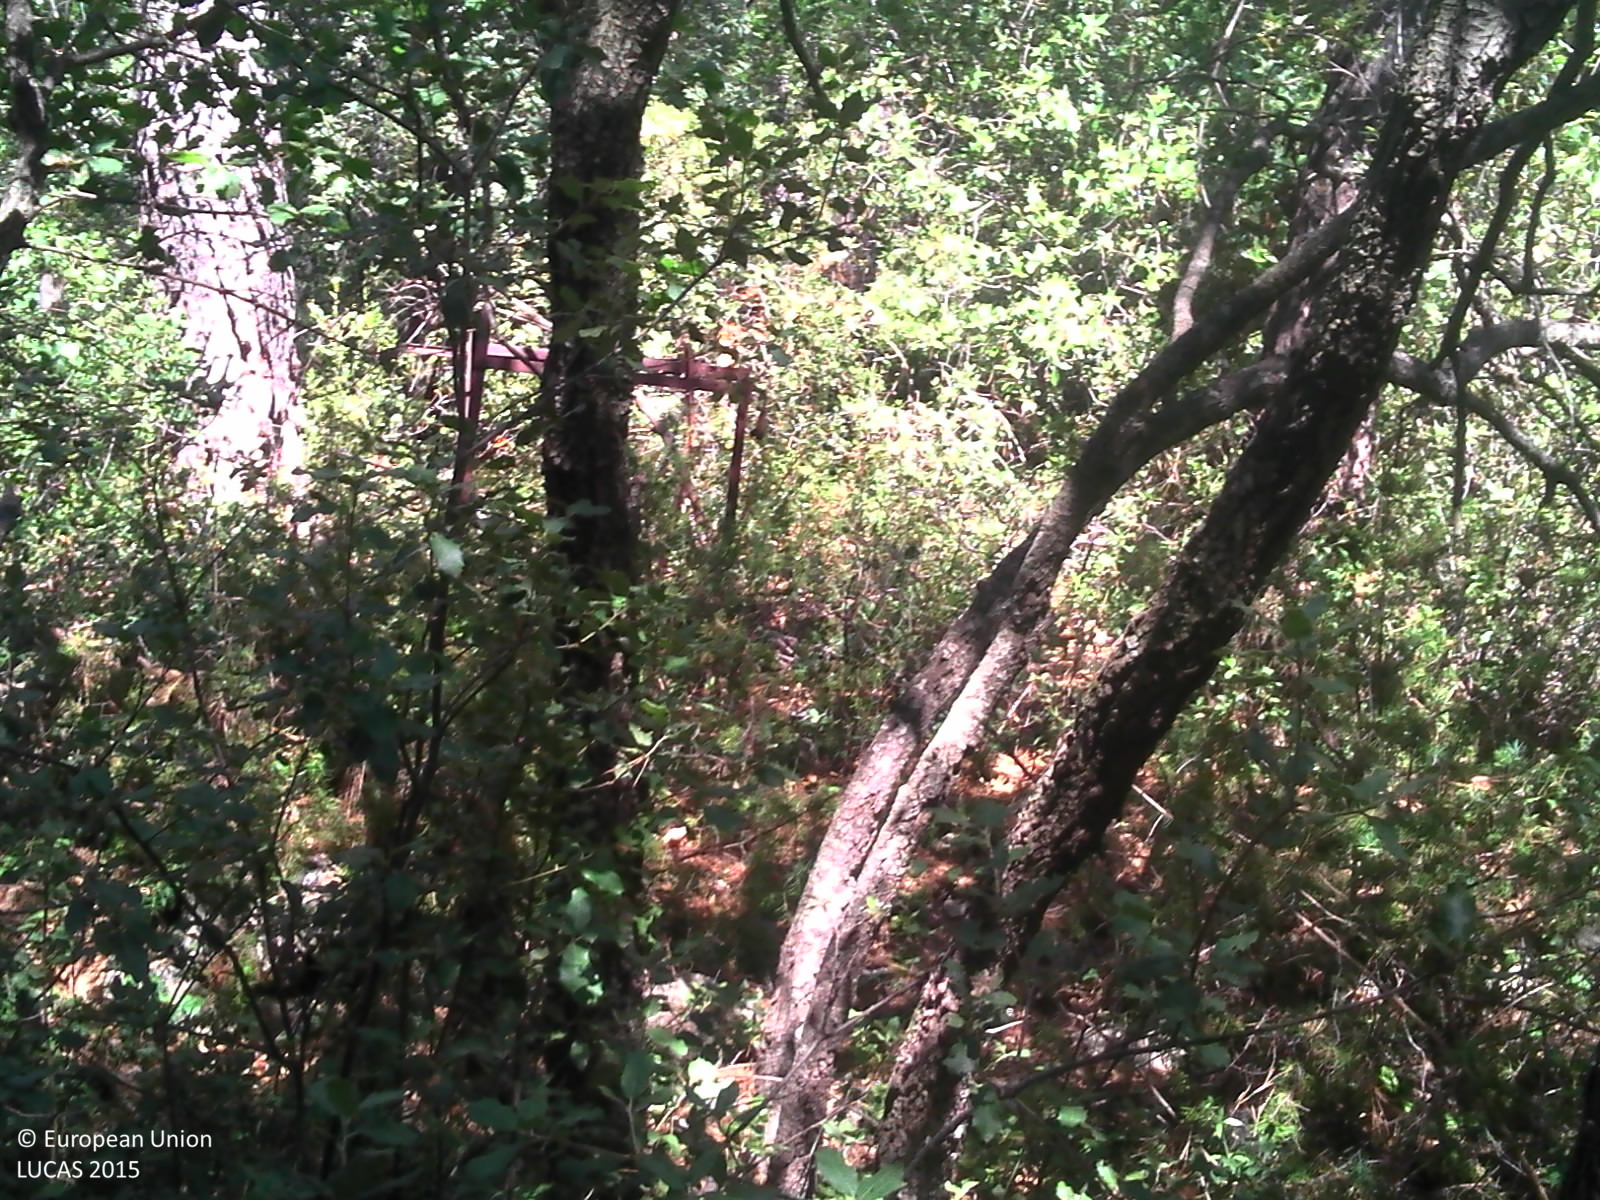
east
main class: Woodland
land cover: Pine dominated mixed woodland
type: coniferous forest of the mediterranean region
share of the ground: > 75 %
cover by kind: coniferous forest trees 45 %, broadleaved forest trees 40 %, herbaceous plants 10 %, shrubs 5 %
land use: Forestry
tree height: > 5 m
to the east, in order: Pine dominated mixed woodland; Shrubland without tree cover; Artificial constructions in urban areas; Pine dominated mixed woodland; Pine dominated coniferous woodland
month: July
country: FR
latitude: 43.6663
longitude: 5.3091
